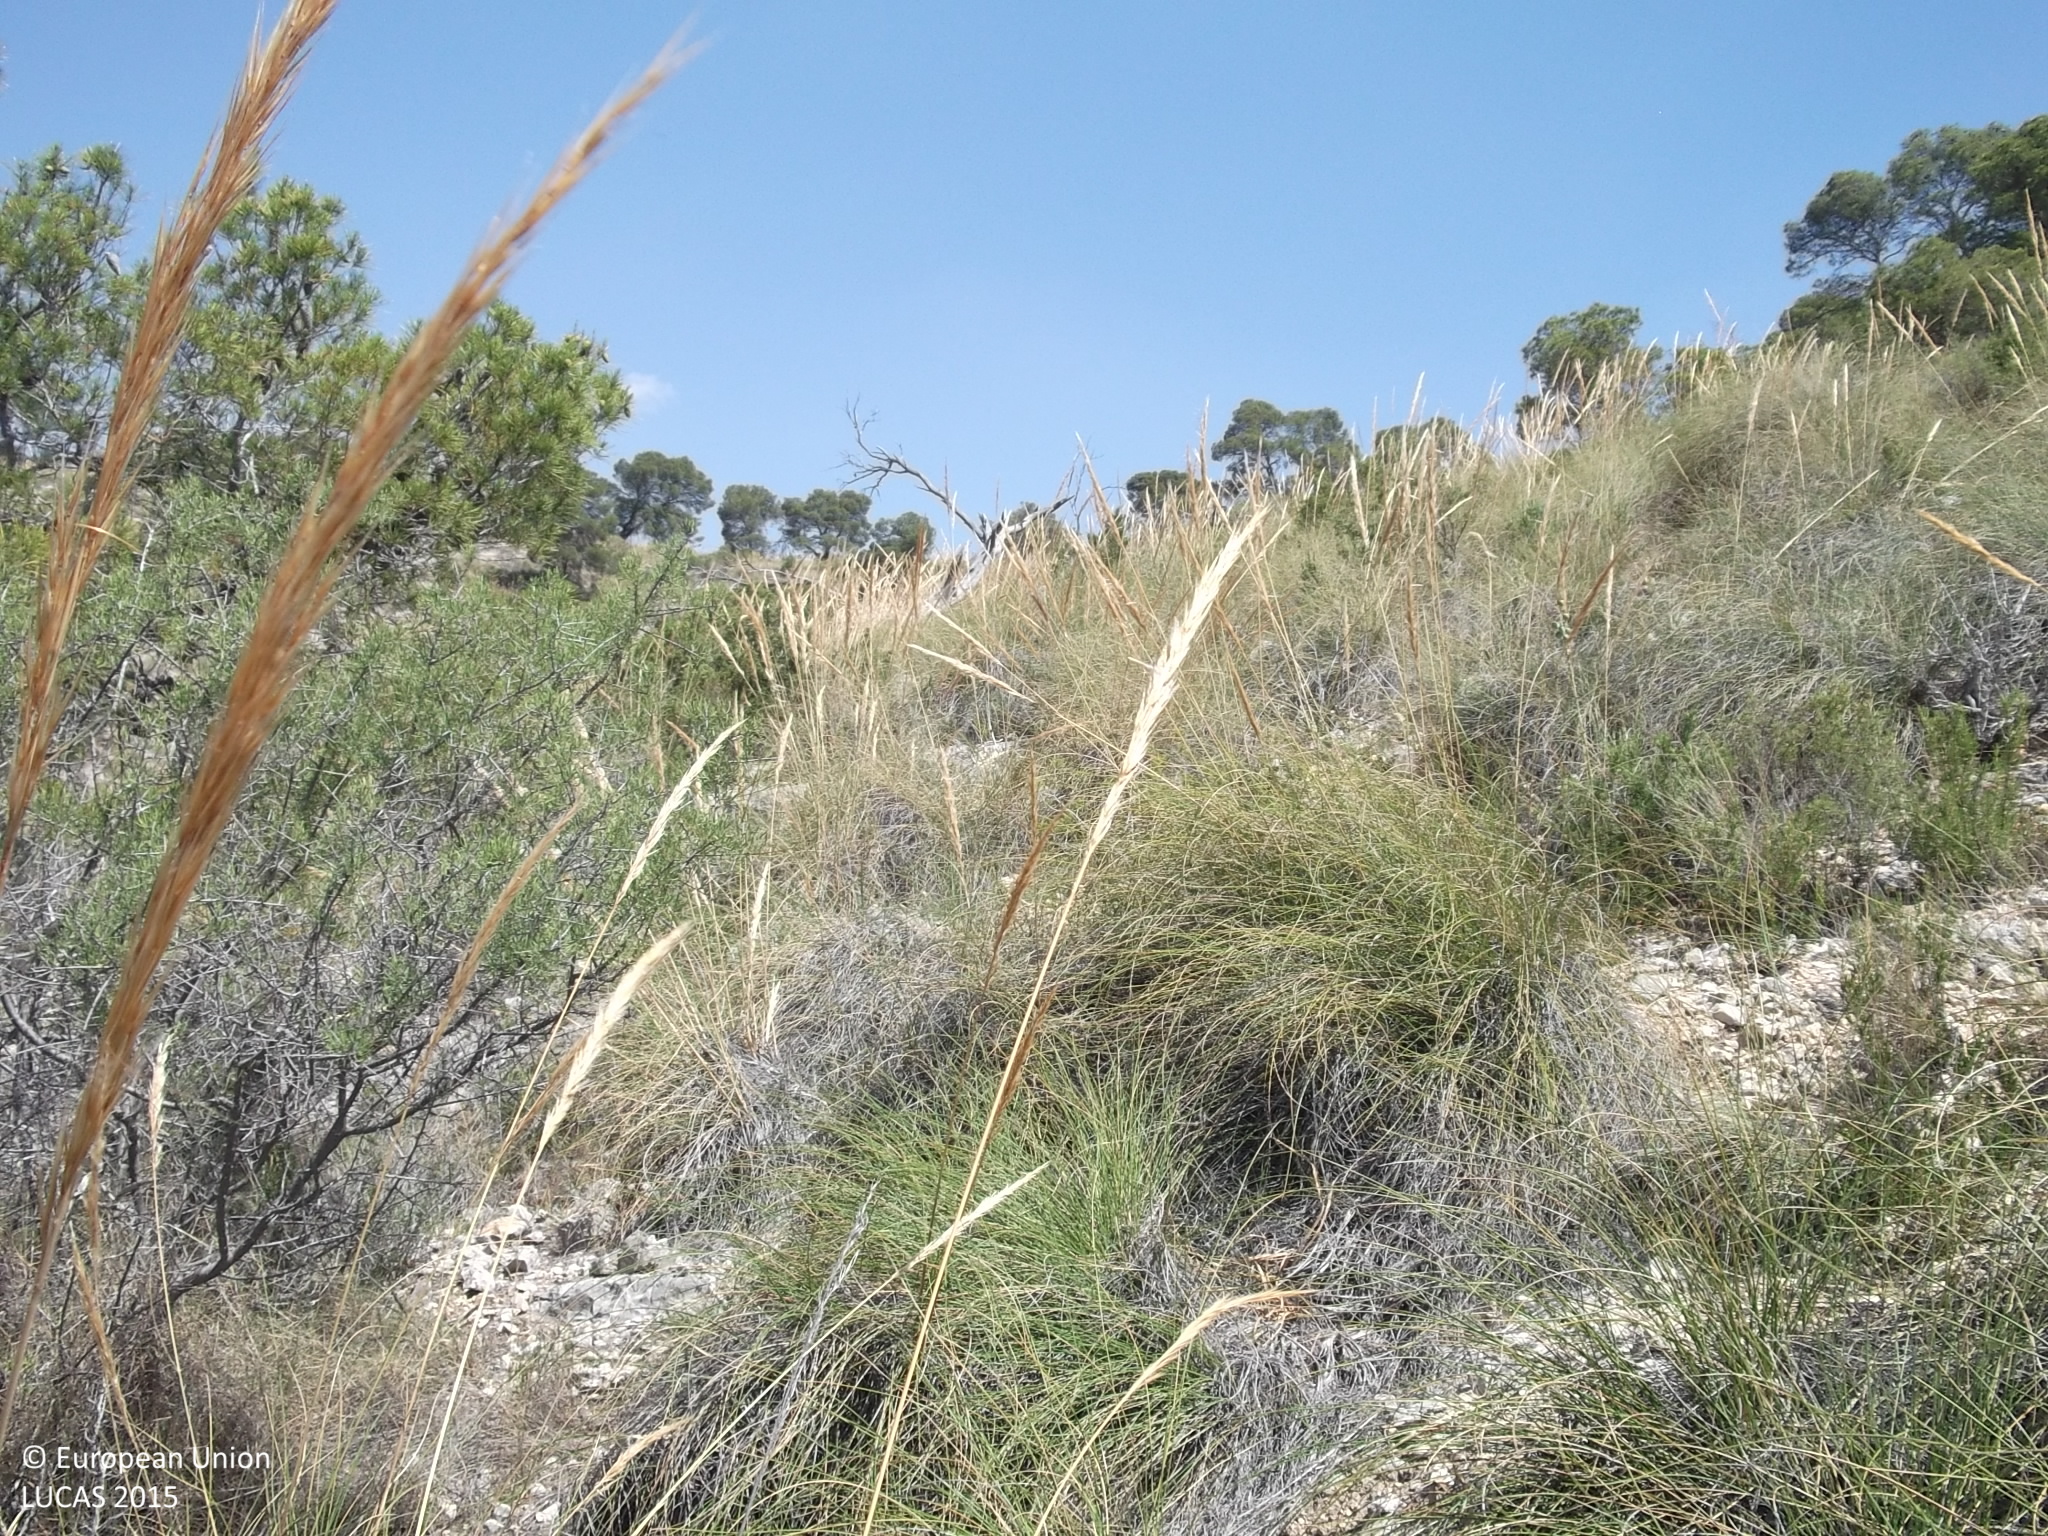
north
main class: Woodland
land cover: Pine dominated coniferous woodland
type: coniferous forest of the mediterranean region
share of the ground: 10 - 25 %
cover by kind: shrubs 30 %, consolidated bare surface 30 %, coniferous forest trees 20 %, herbaceous plants 20 %
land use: Semi-natural and natural areas not in use
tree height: > 5 m
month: May
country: ES
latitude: 38.4452
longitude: -1.4372
